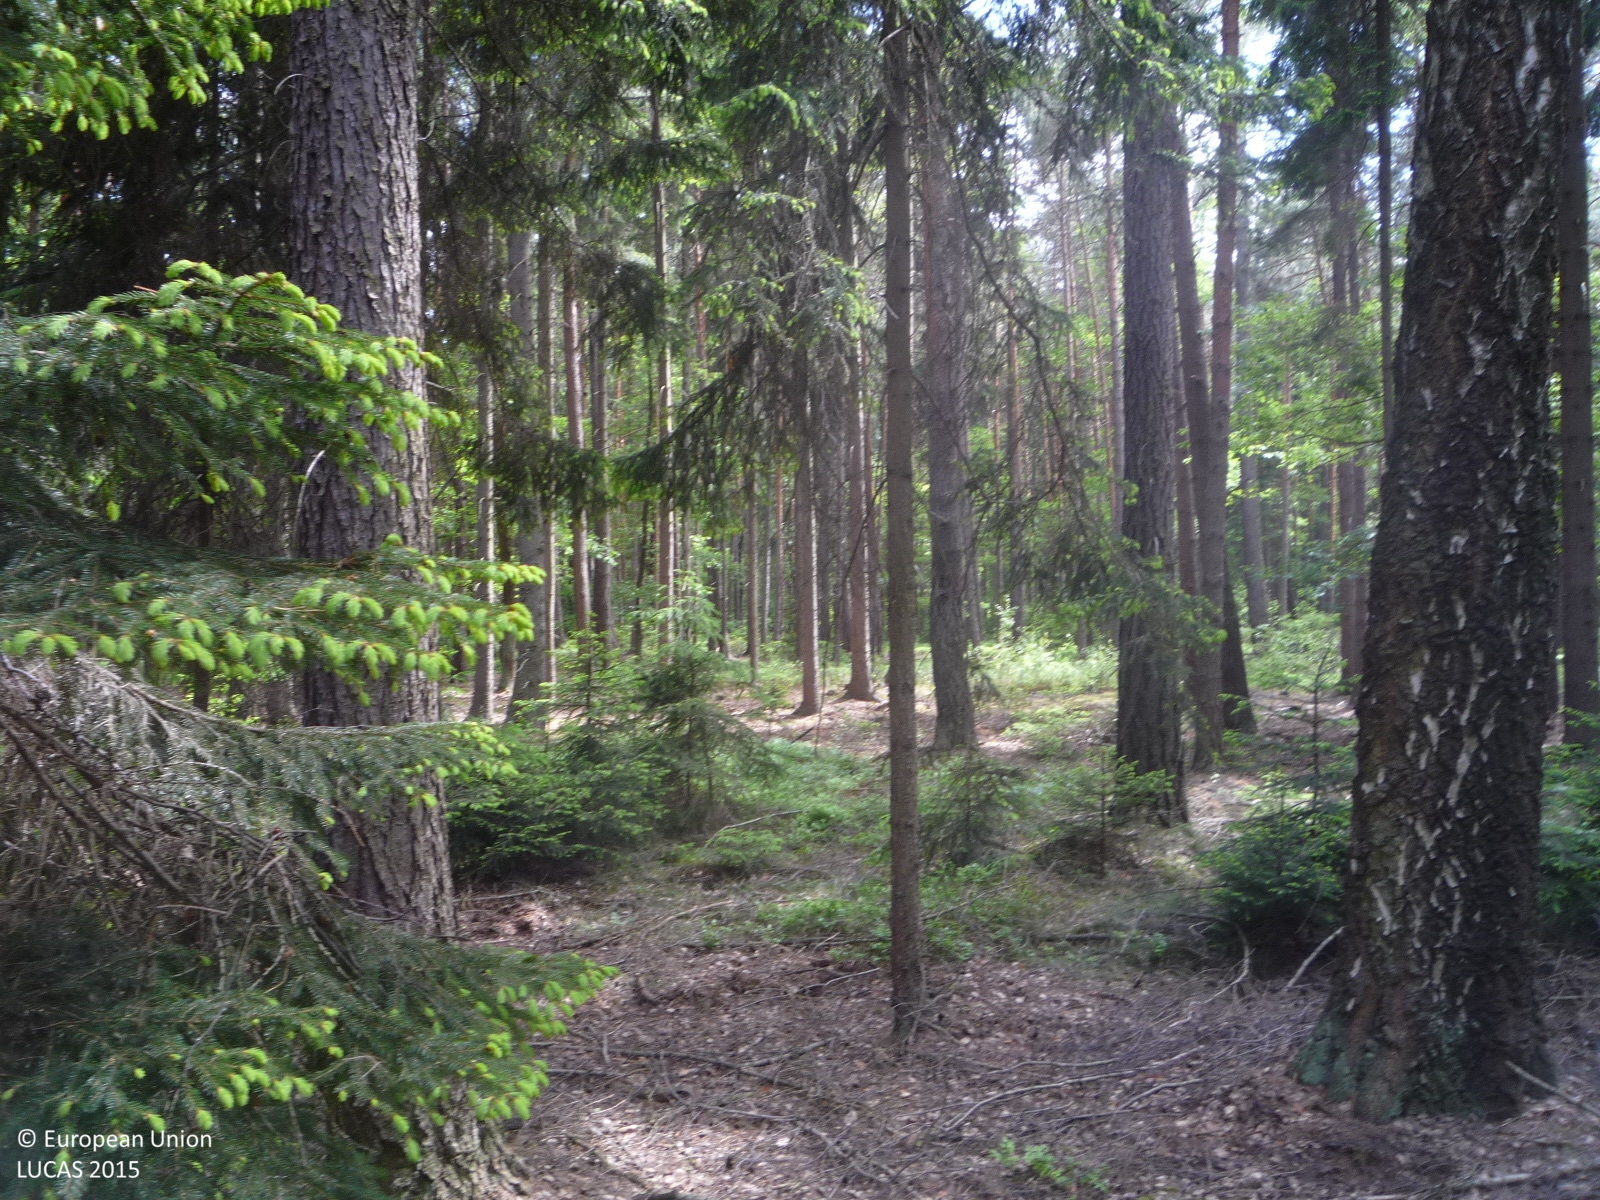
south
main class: Woodland
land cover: Pine dominated coniferous woodland
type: hemiboreal forest and nemoral coniferous forest and mixed broadleaved-coniferous forest
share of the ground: > 75 %
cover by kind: coniferous forest trees 90 %, broadleaved forest trees 10 %
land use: Forestry
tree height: > 5 m
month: June
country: CZ
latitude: 50.2450
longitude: 13.8570
